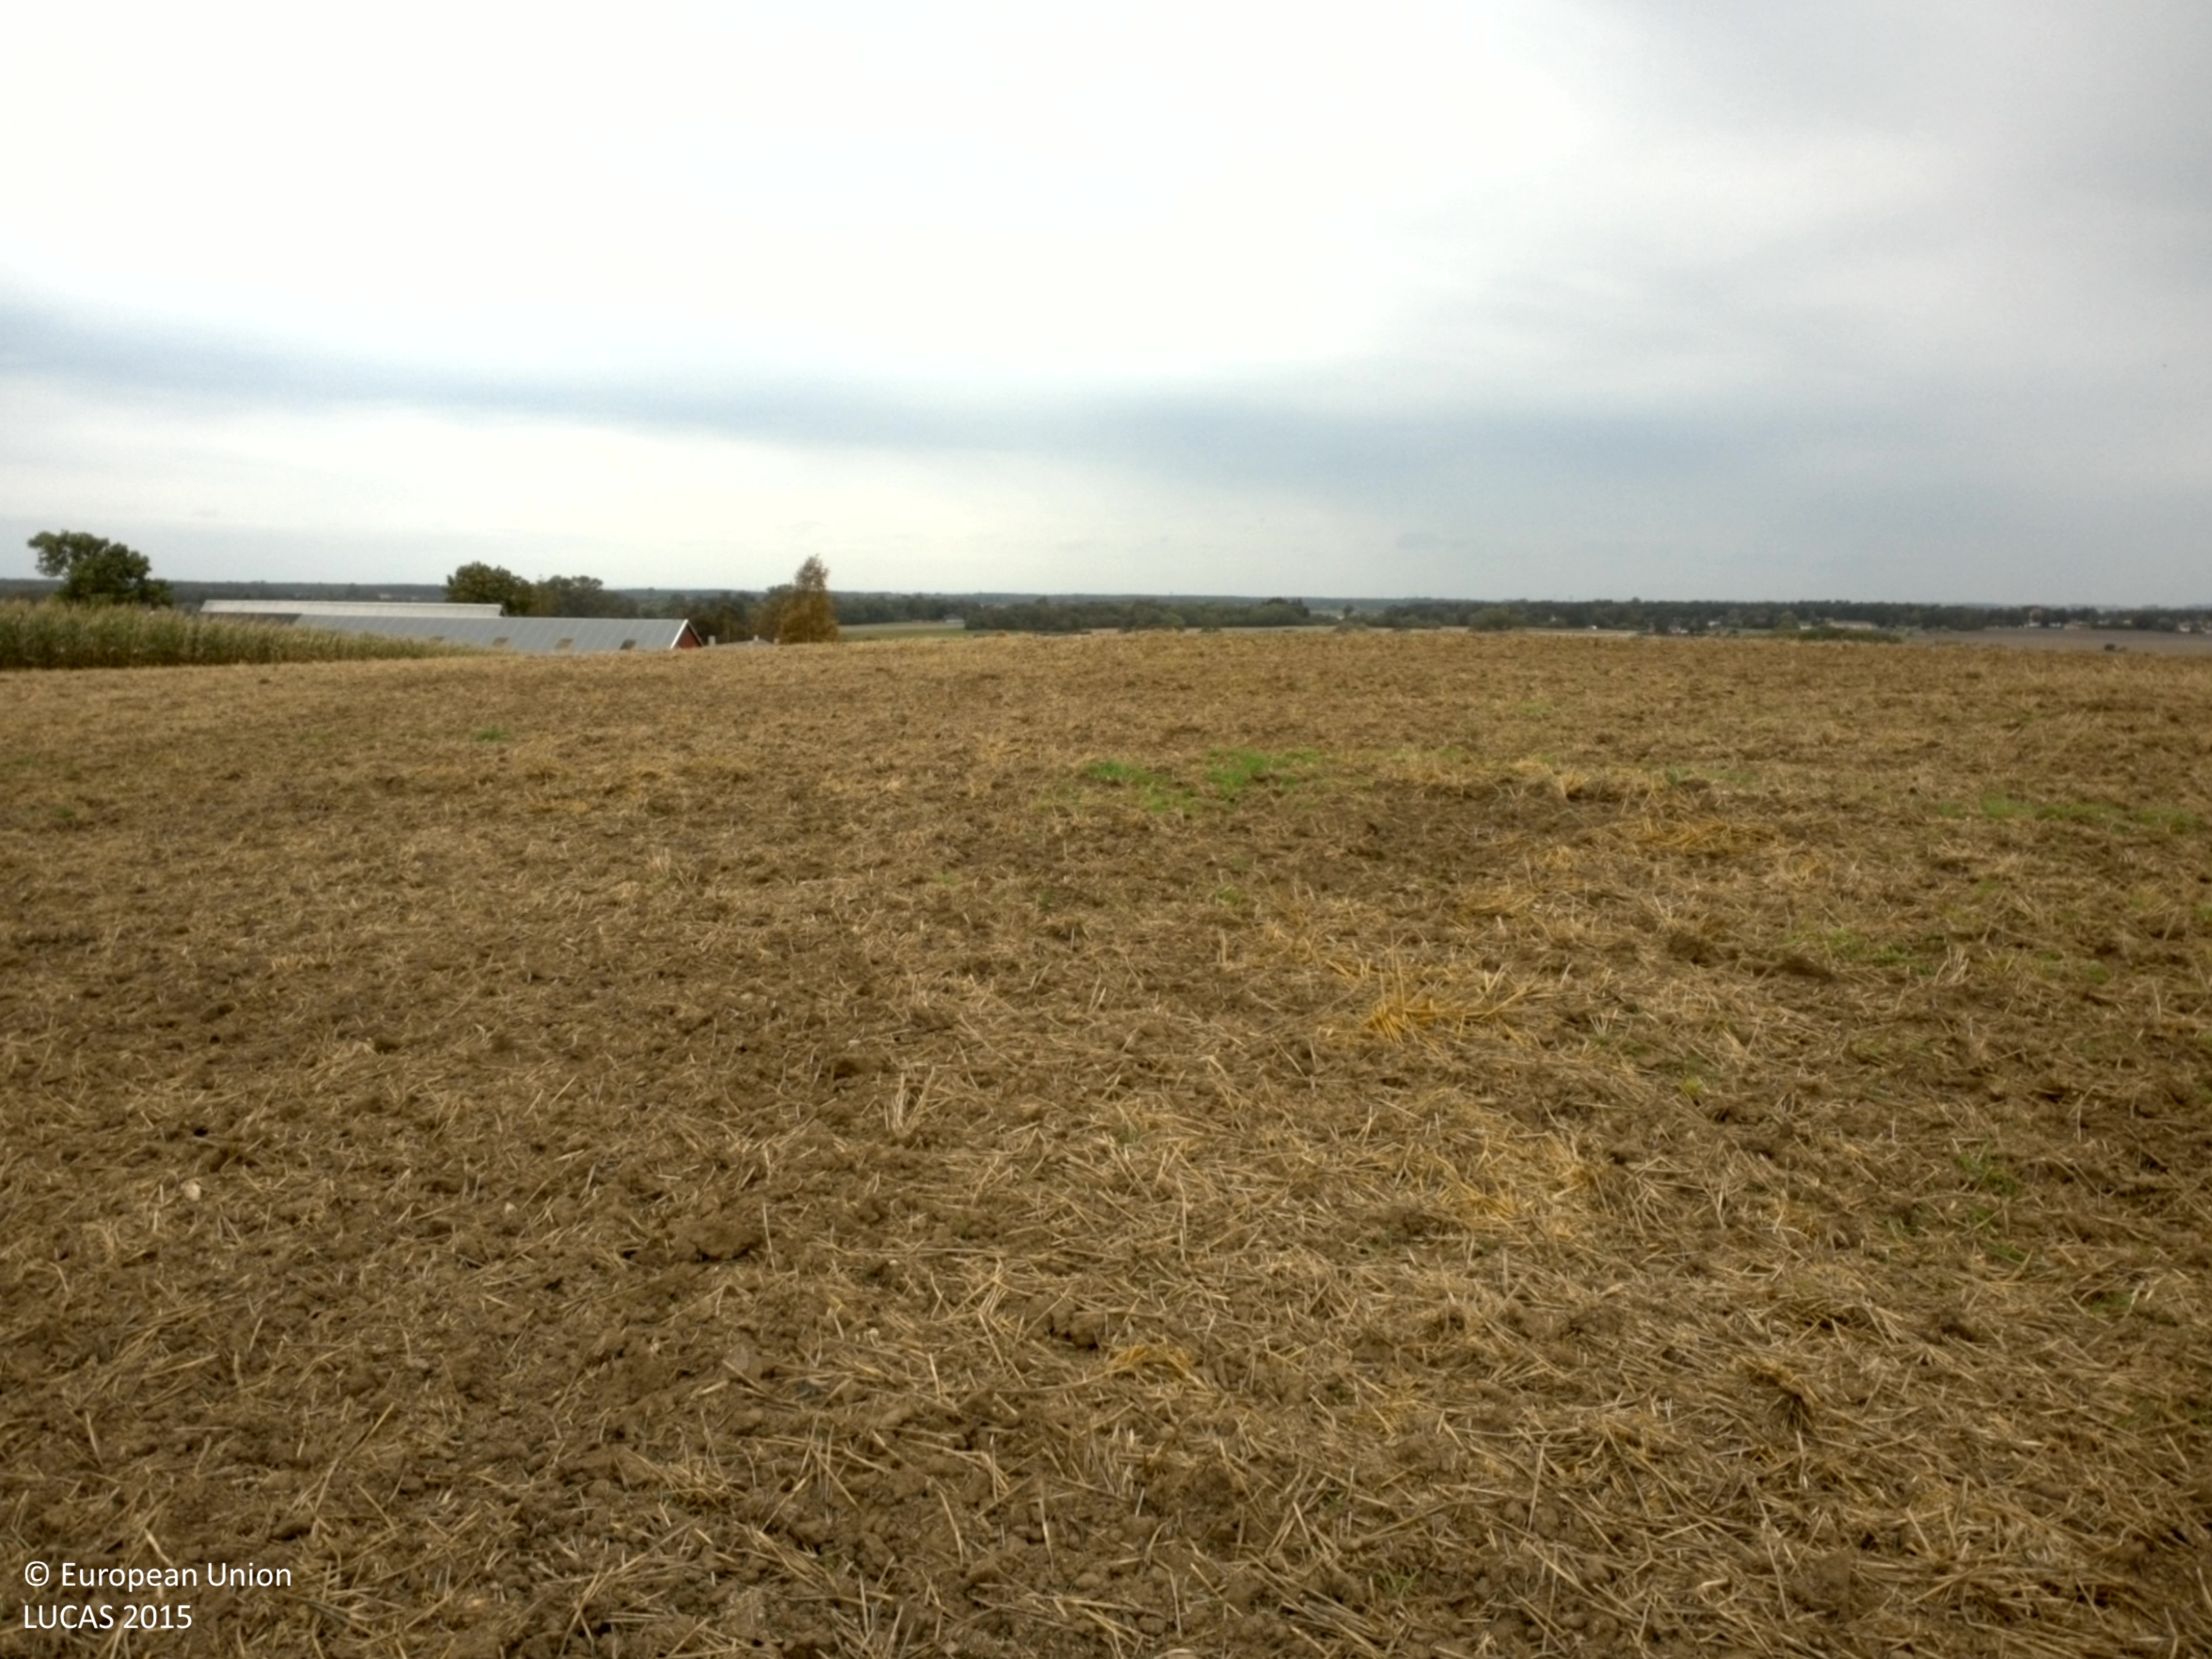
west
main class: Cropland
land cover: Common wheat
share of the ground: < 10 %
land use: Agriculture (excluding fallow land and kitchen gardens)
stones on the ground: < 10 %
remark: Harvested field
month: October
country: SE
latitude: 55.8278
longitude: 13.0469
